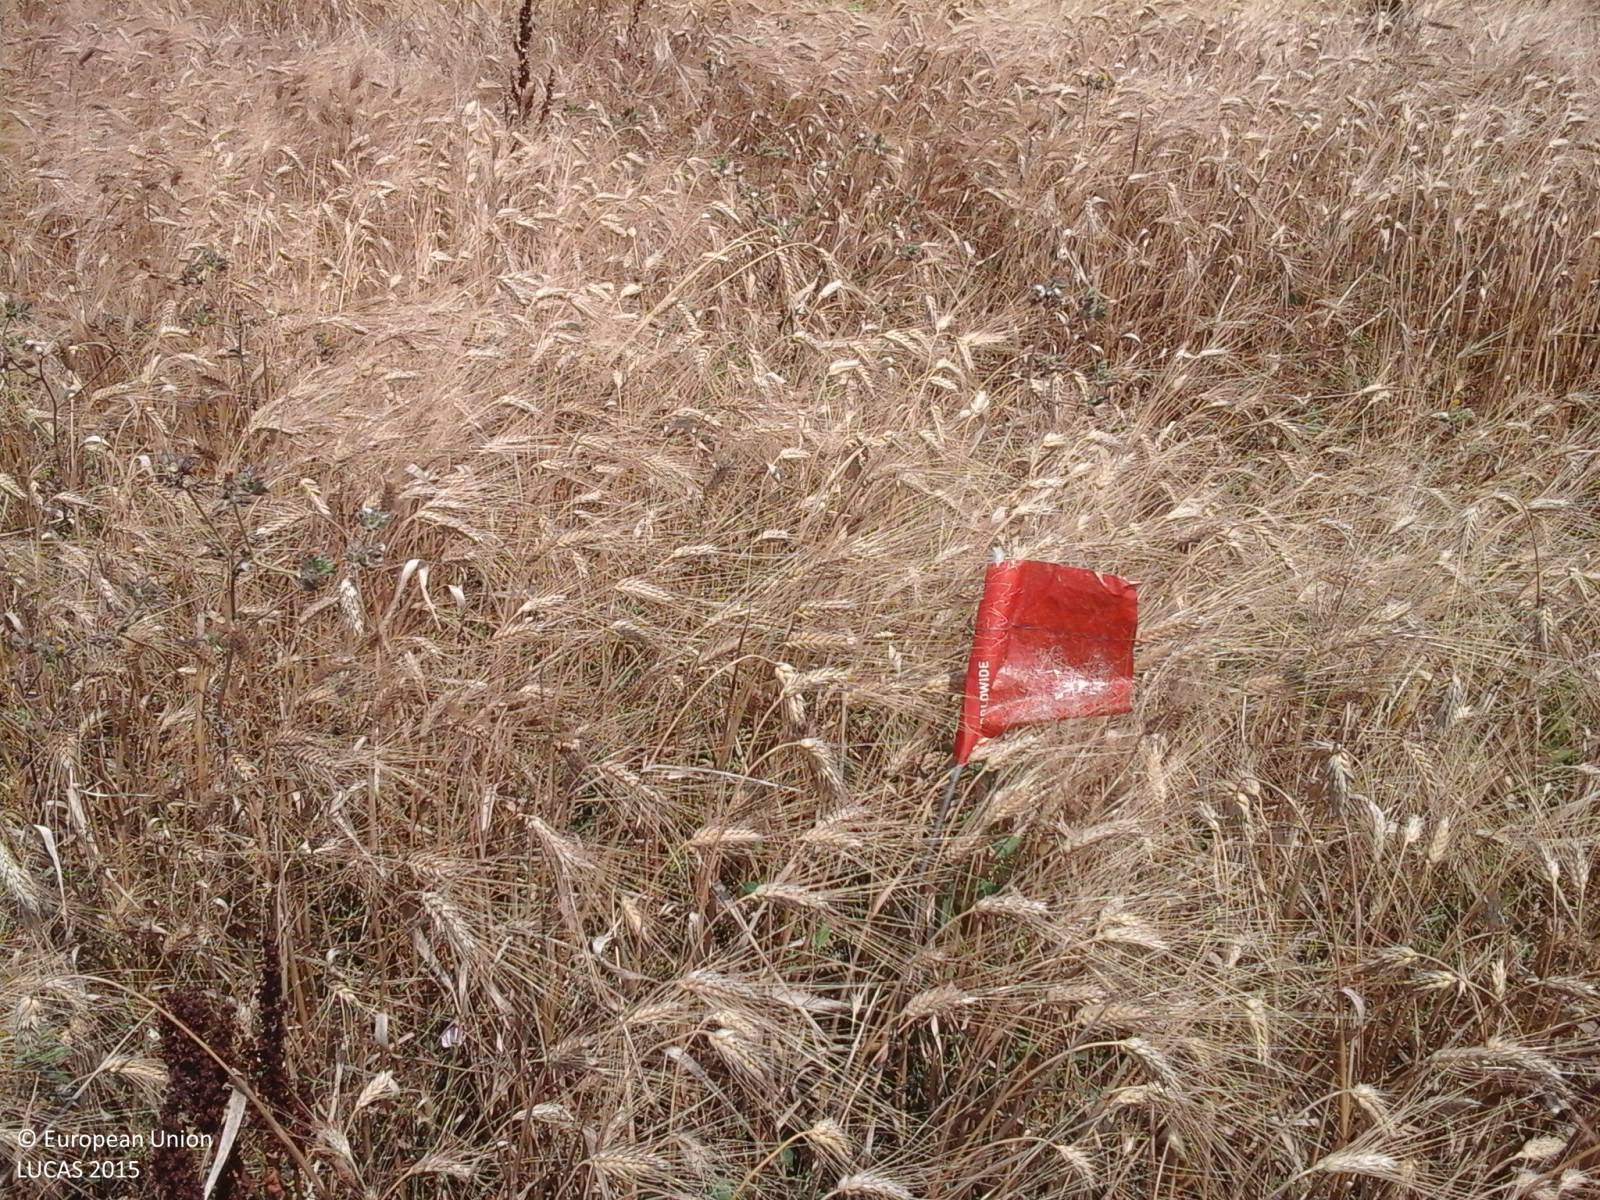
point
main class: Cropland
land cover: Common wheat
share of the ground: > 75 %
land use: Agriculture (excluding fallow land and kitchen gardens)
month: July
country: IT
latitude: 39.5716
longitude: 8.7848
